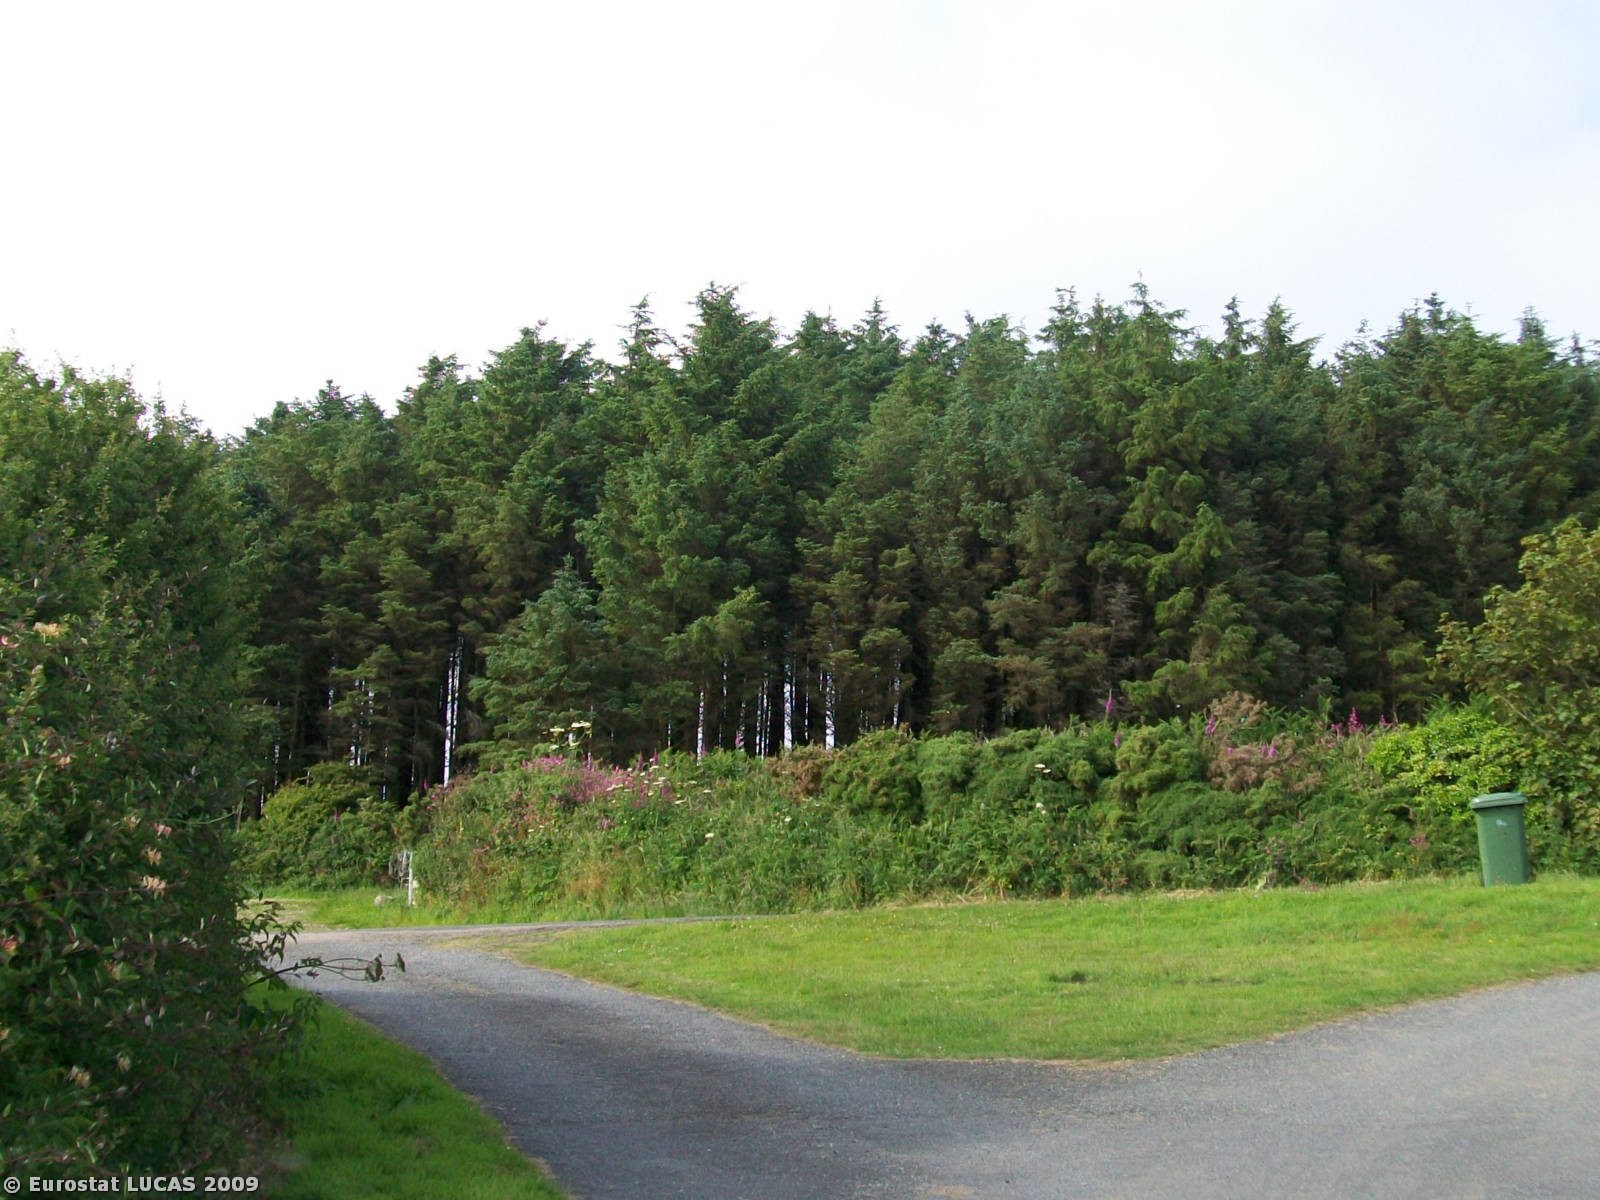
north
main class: Grassland
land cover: Grassland without tree/shrub cover
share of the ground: > 75 %
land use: Agriculture (excluding fallow land and kitchen gardens)
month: June
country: GB
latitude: 50.1544
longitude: -5.5383
